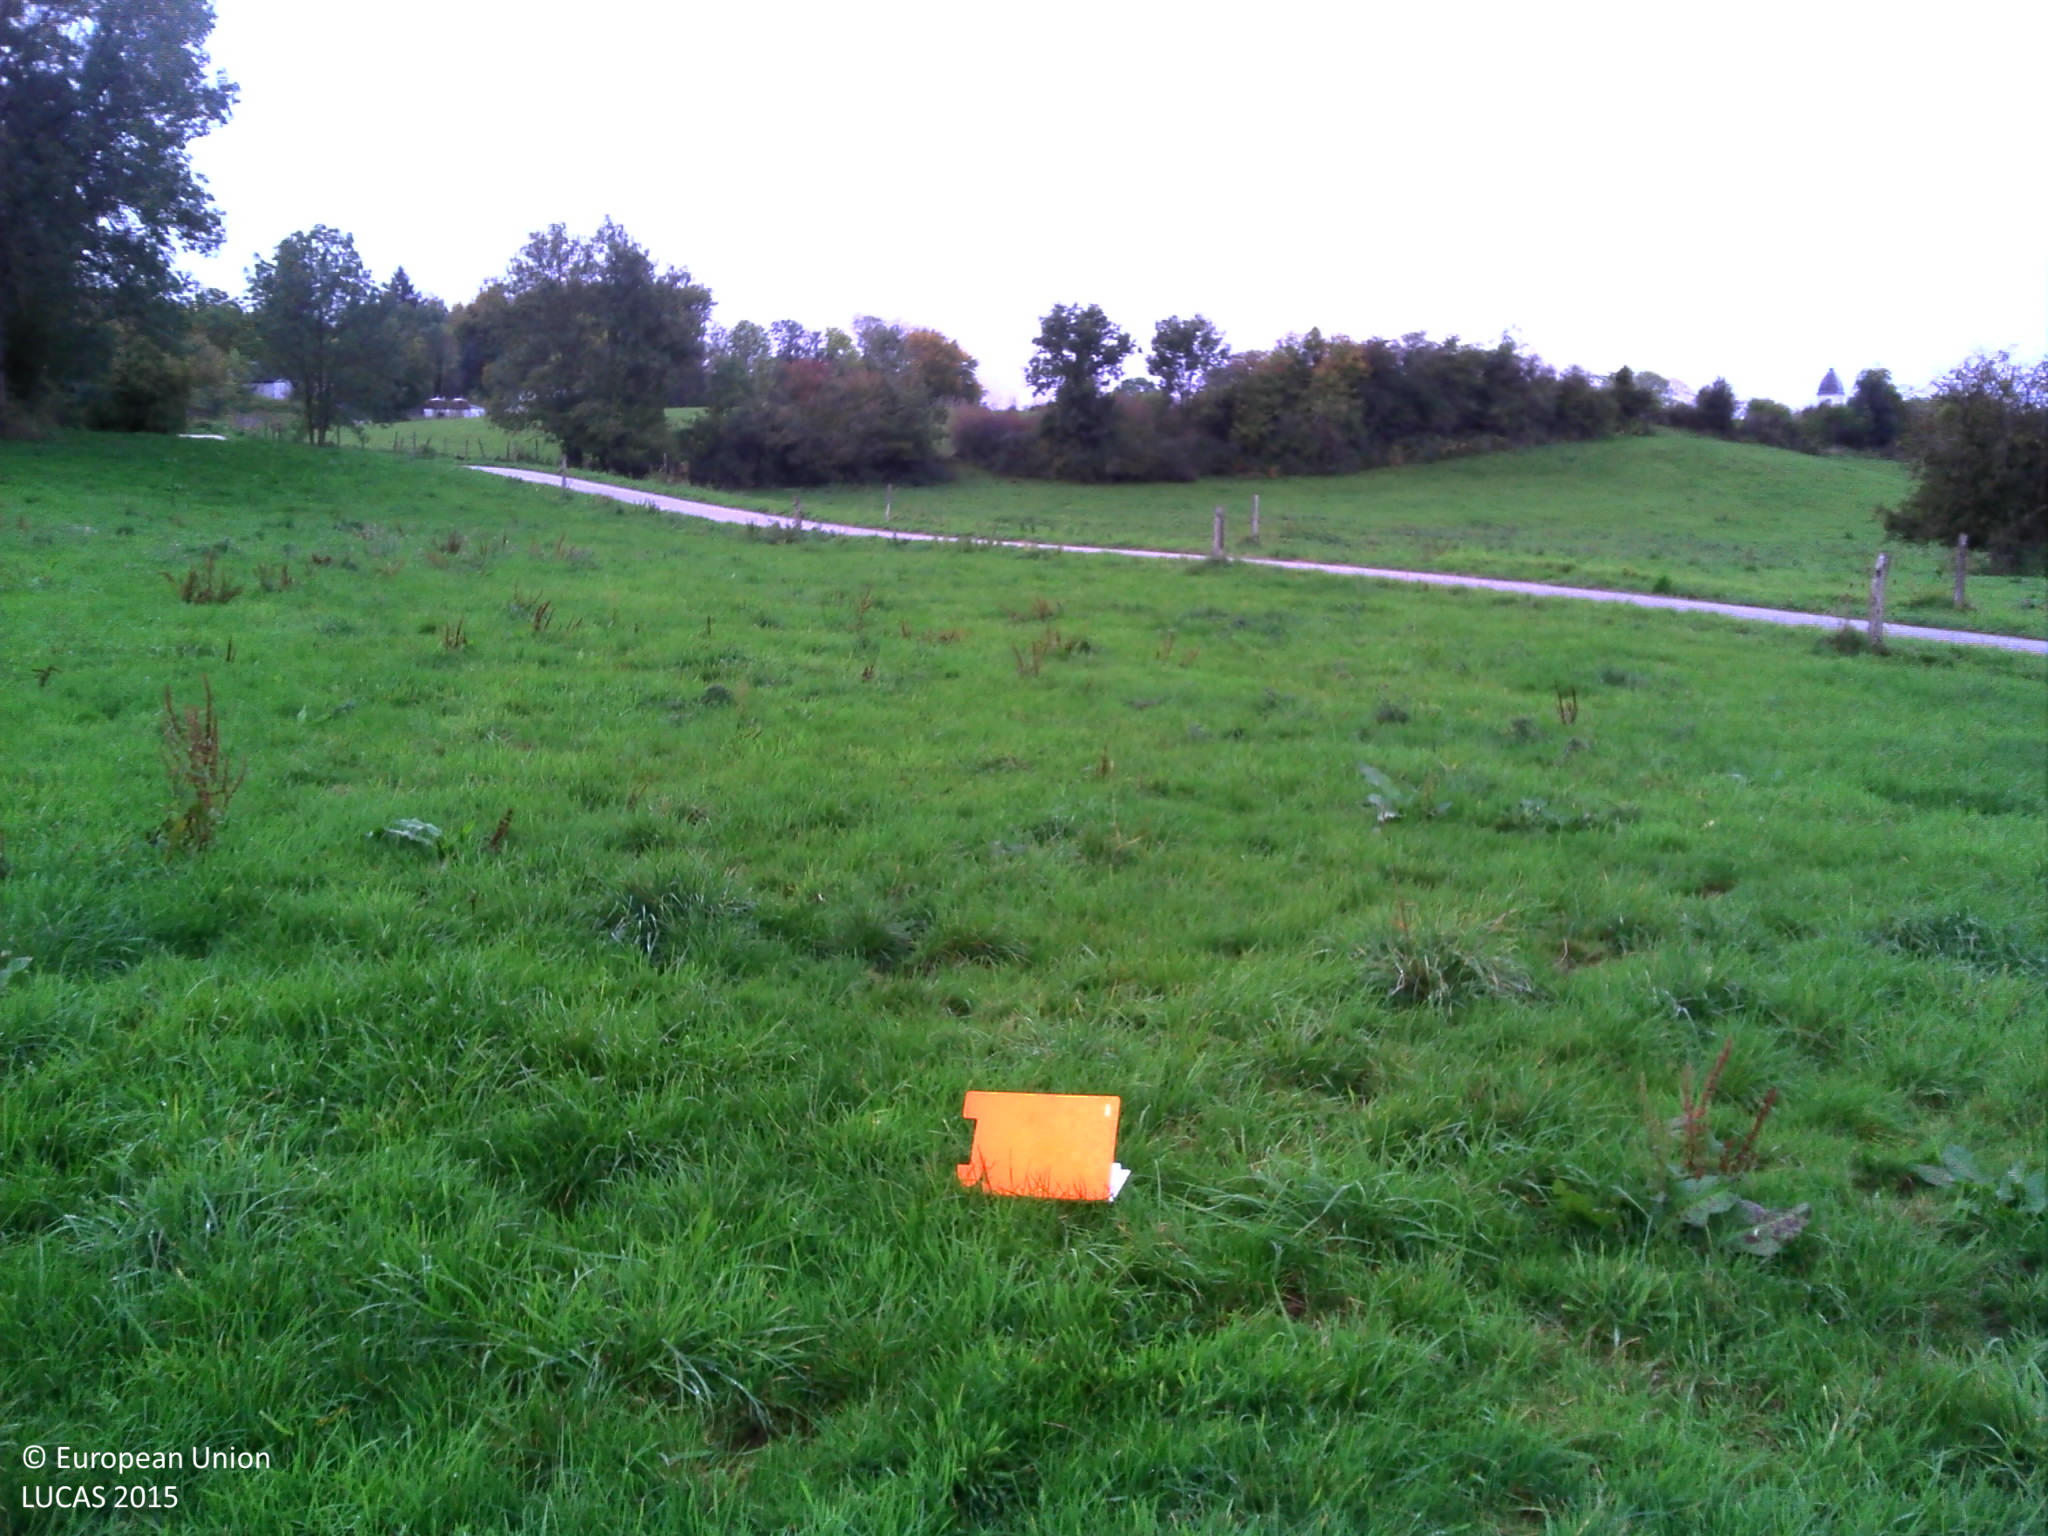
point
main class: Grassland
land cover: Grassland without tree/shrub cover
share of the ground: > 75 %
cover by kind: herbaceous plants 100 %
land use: Agriculture (excluding fallow land and kitchen gardens)
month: October
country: FR
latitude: 47.0201
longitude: 6.1211
